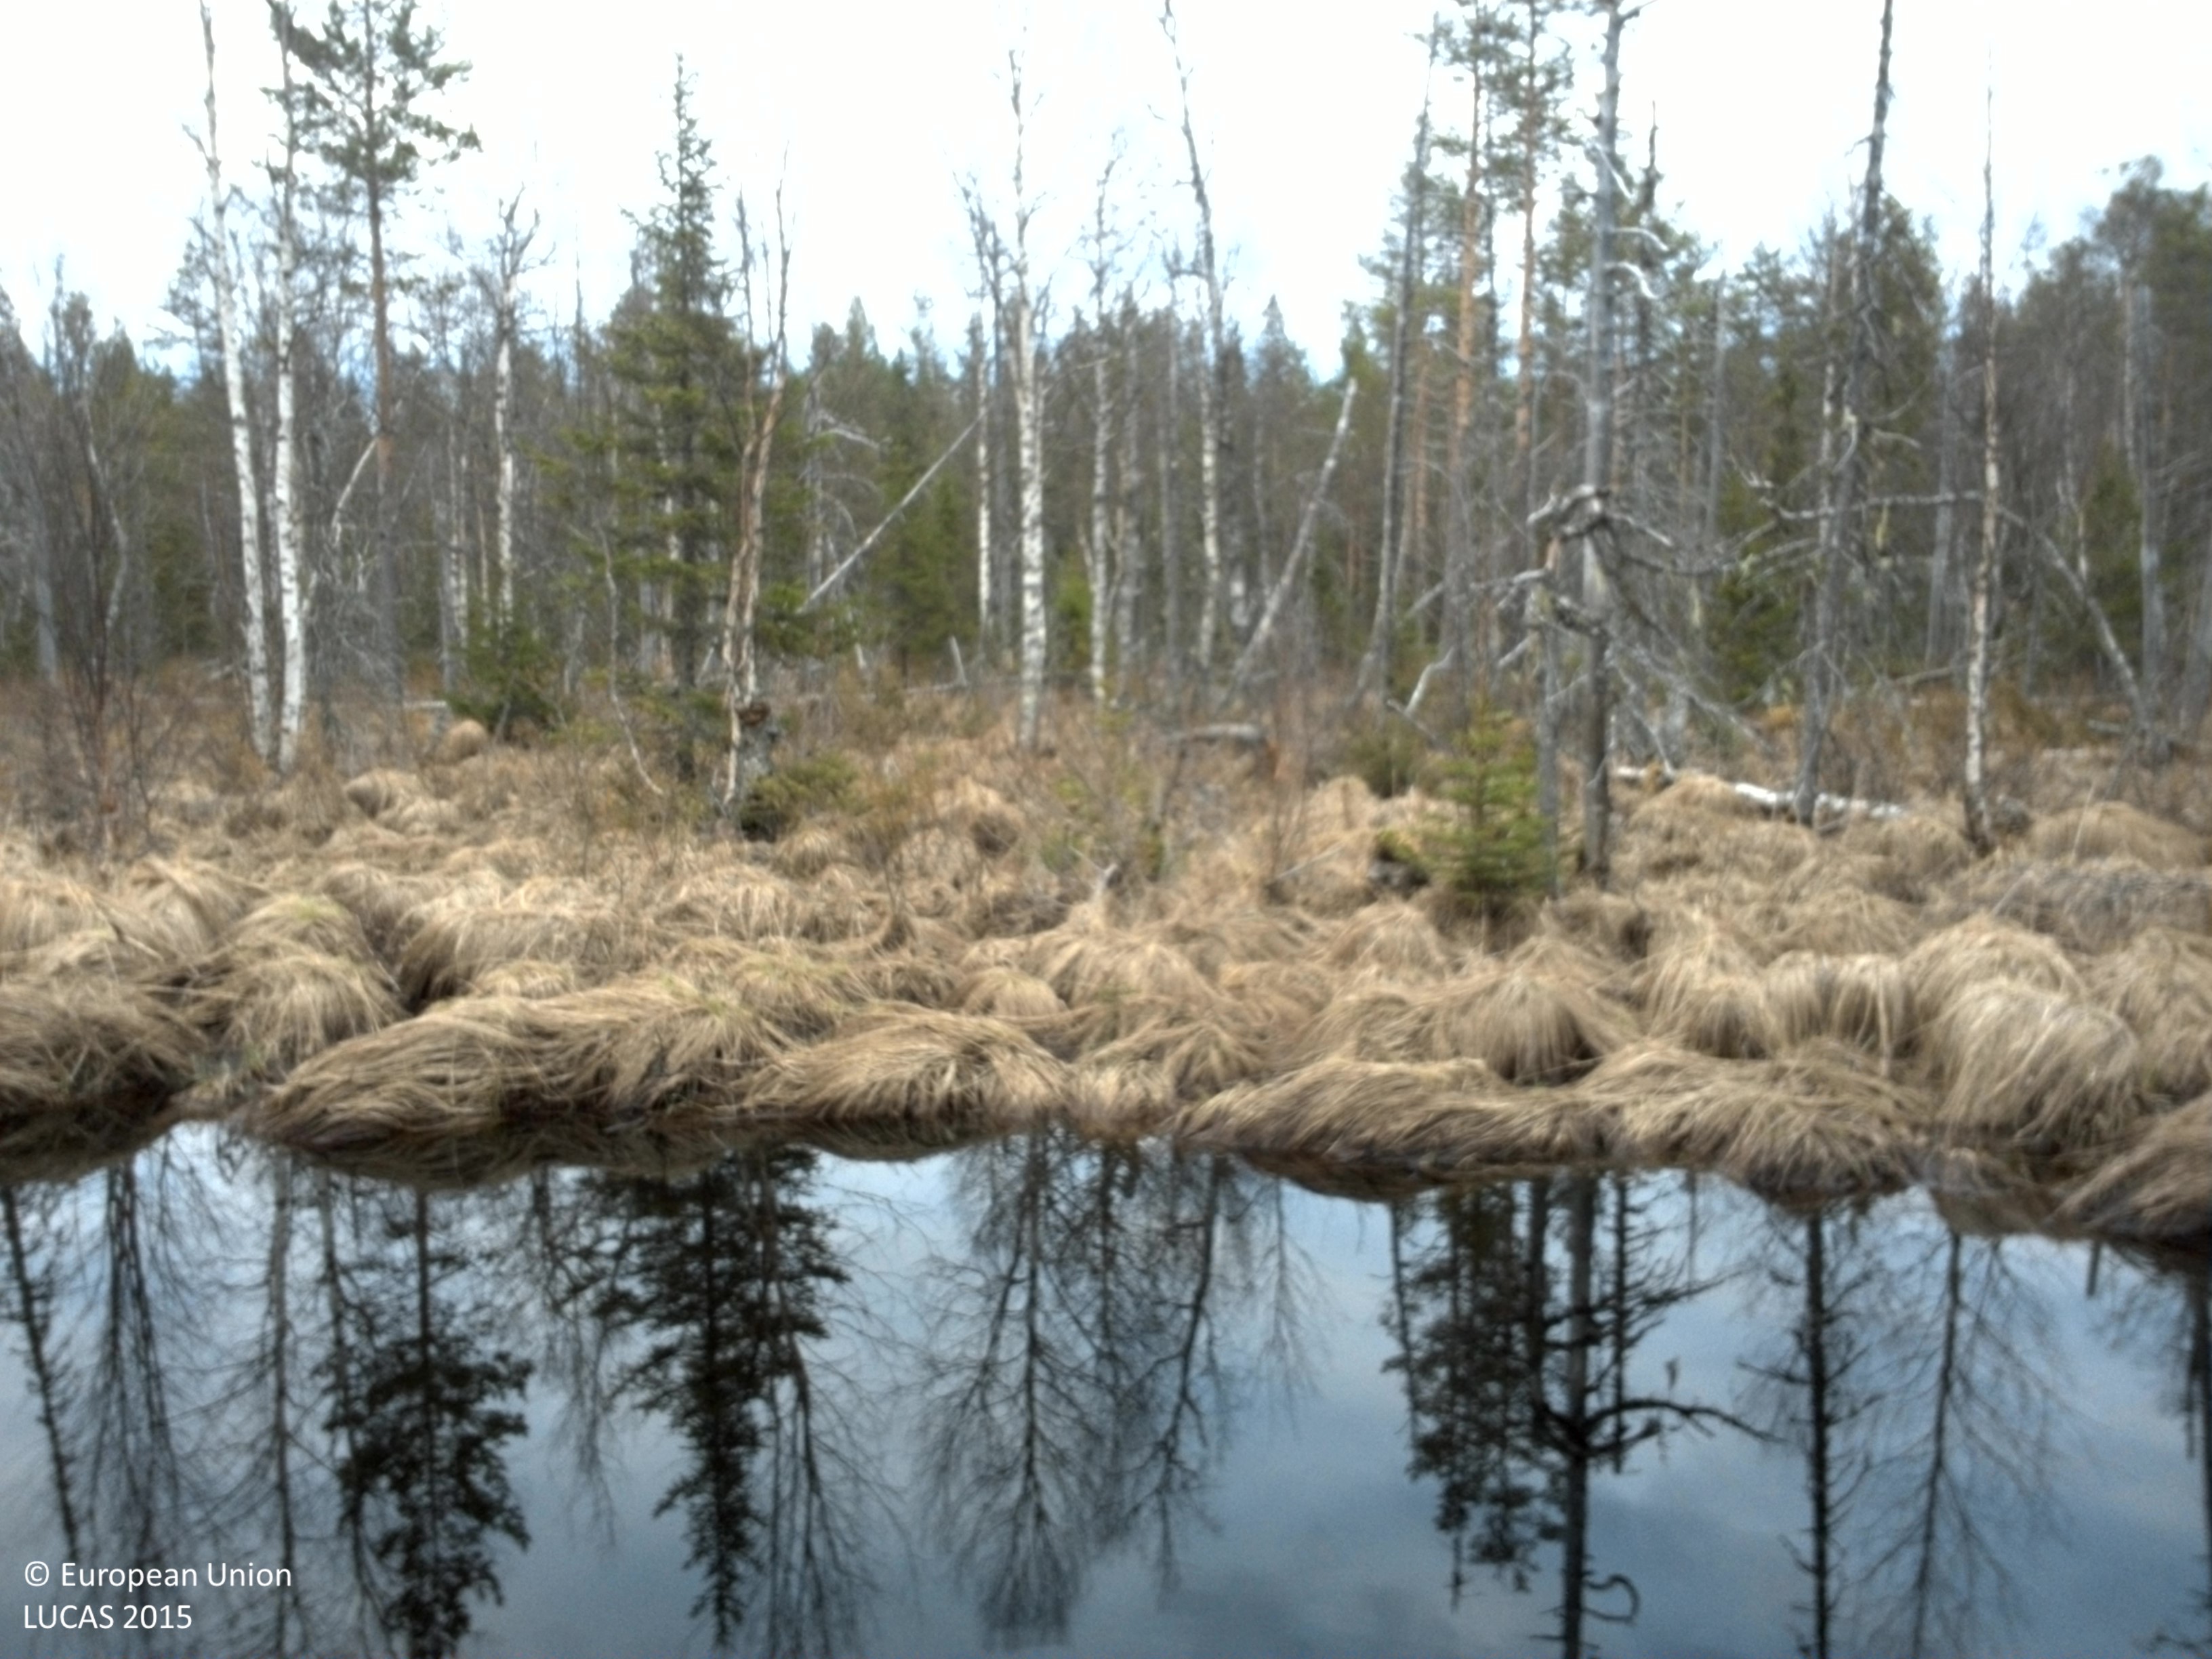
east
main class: Woodland
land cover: Broadleaved woodland
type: boreal forest
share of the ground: > 75 %
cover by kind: broadleaved forest trees 70 %, herbaceous plants 20 %, coniferous forest trees 10 %
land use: Semi-natural and natural areas not in use
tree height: > 5 m
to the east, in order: Broadleaved woodland; Spruce dominated mixed woodland; Pine dominated coniferous woodland
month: May
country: SE
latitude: 62.6752
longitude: 14.9593
